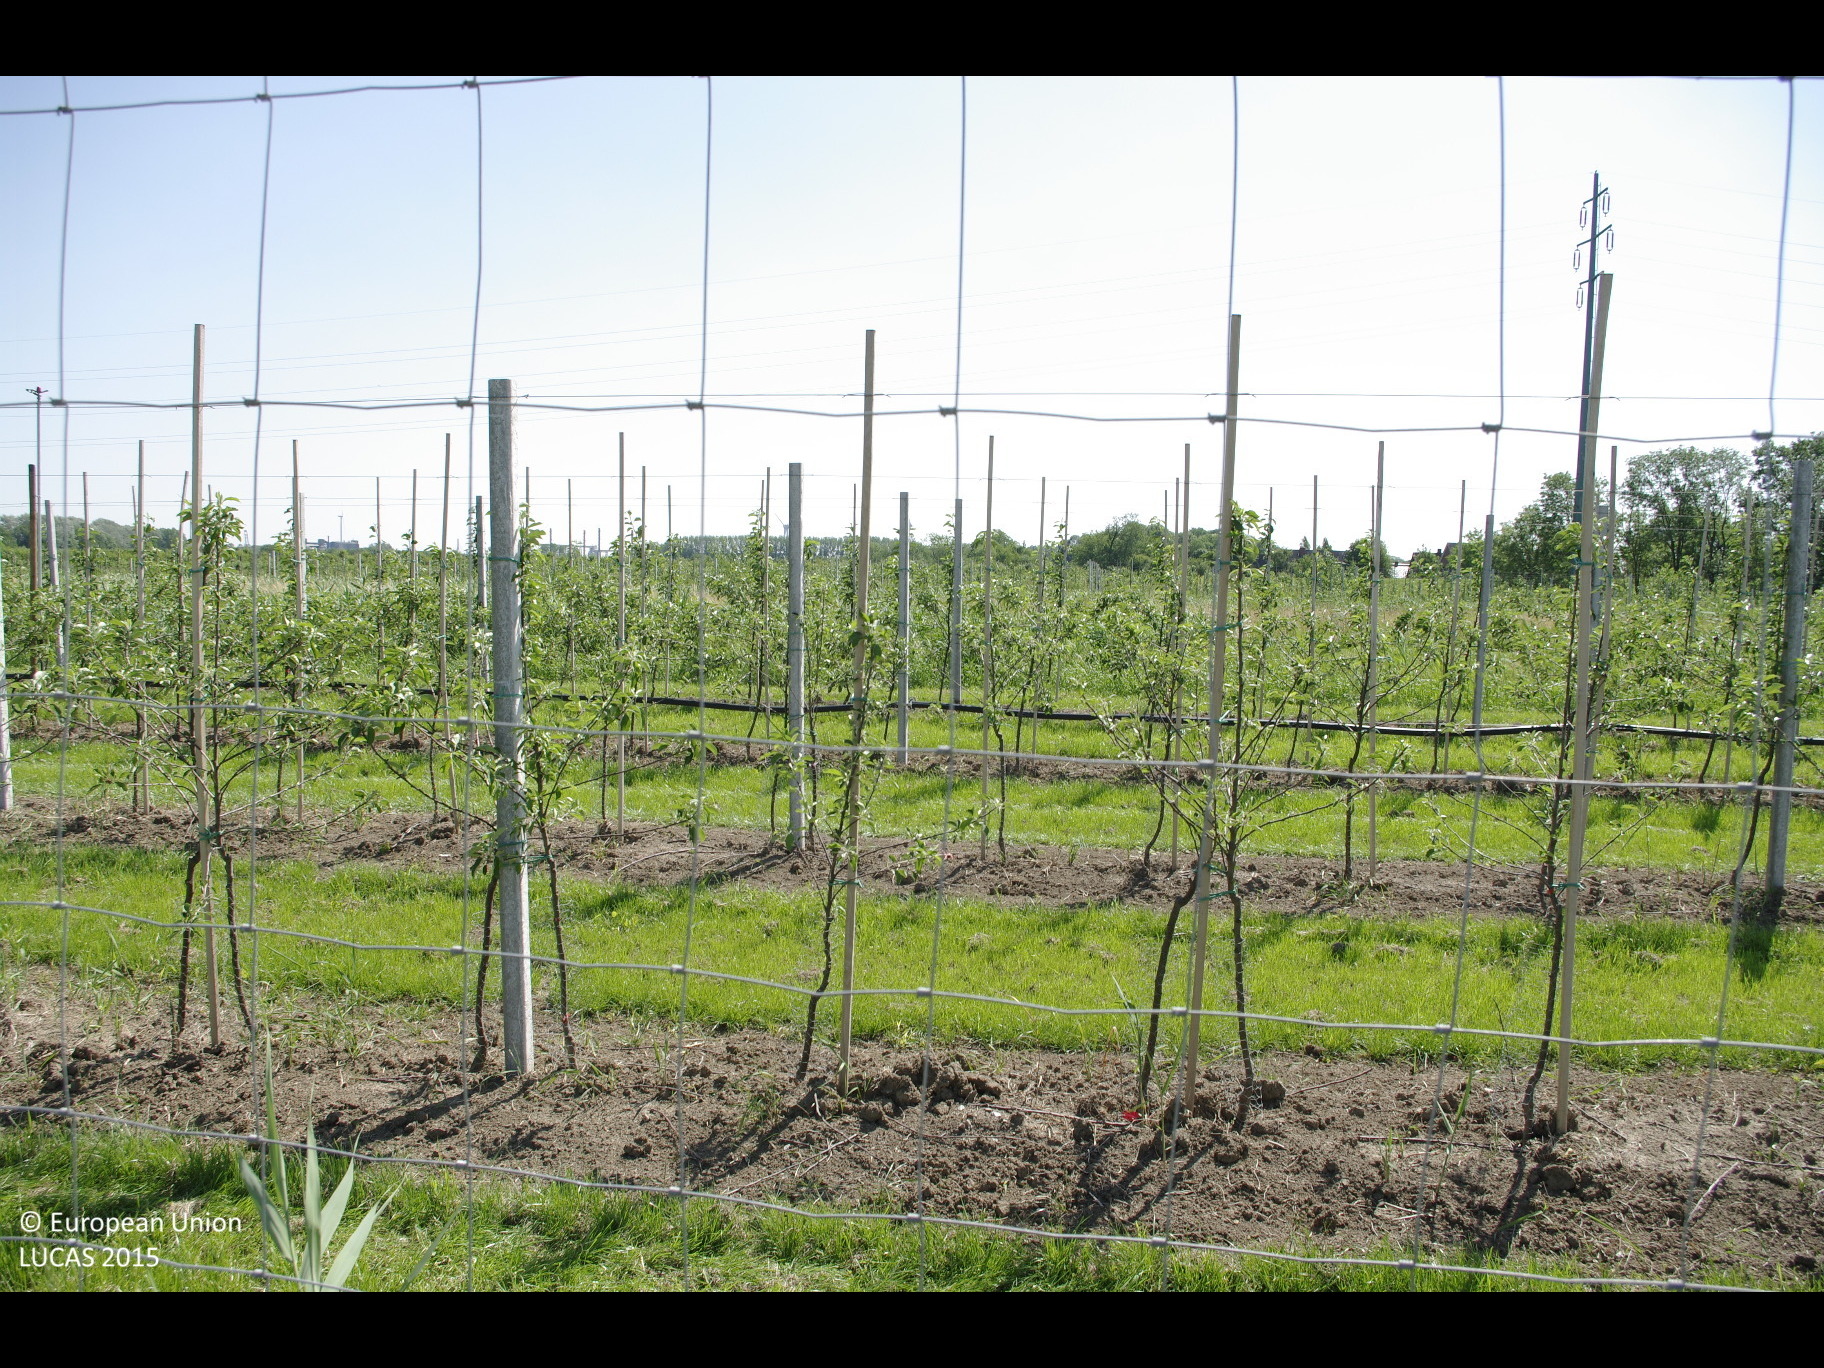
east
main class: Grassland
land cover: Grassland without tree/shrub cover
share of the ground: > 75 %
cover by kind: herbaceous plants 100 %
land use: Agriculture (excluding fallow land and kitchen gardens)
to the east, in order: Grassland without tree/shrub cover; Ditches and canals; Apple fruit; Grassland with sparse tree/shrub cover; Electric lines; Grassland with sparse tree/shrub cover; Inland fresh running water; Grassland without tree/shrub cover; Apple fruit; Grassland with sparse tree/shrub cover; Apple fruit
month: July
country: DE
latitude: 53.5097
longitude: 9.8644
